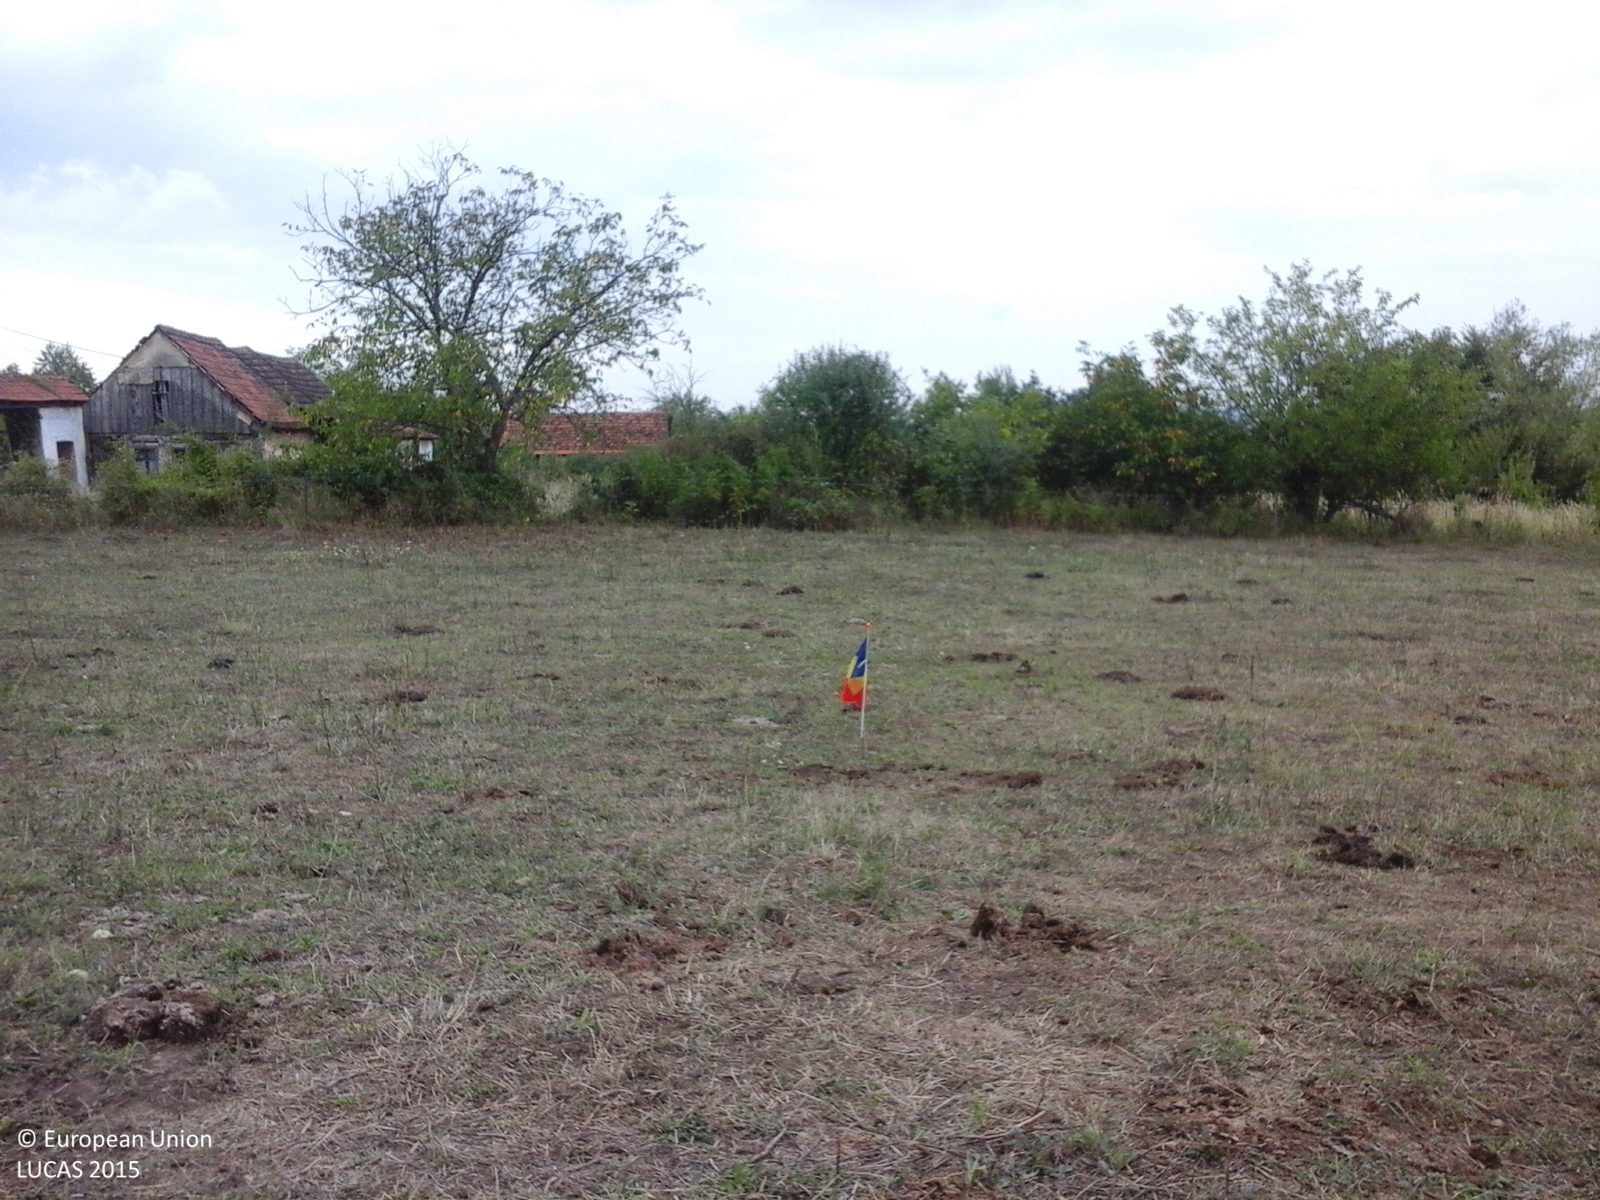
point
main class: Grassland
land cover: Grassland without tree/shrub cover
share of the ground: > 75 %
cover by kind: herbaceous plants 100 %
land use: Agriculture (excluding fallow land and kitchen gardens)
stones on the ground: < 10 %
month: August
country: RO
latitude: 45.4659
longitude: 21.7377
